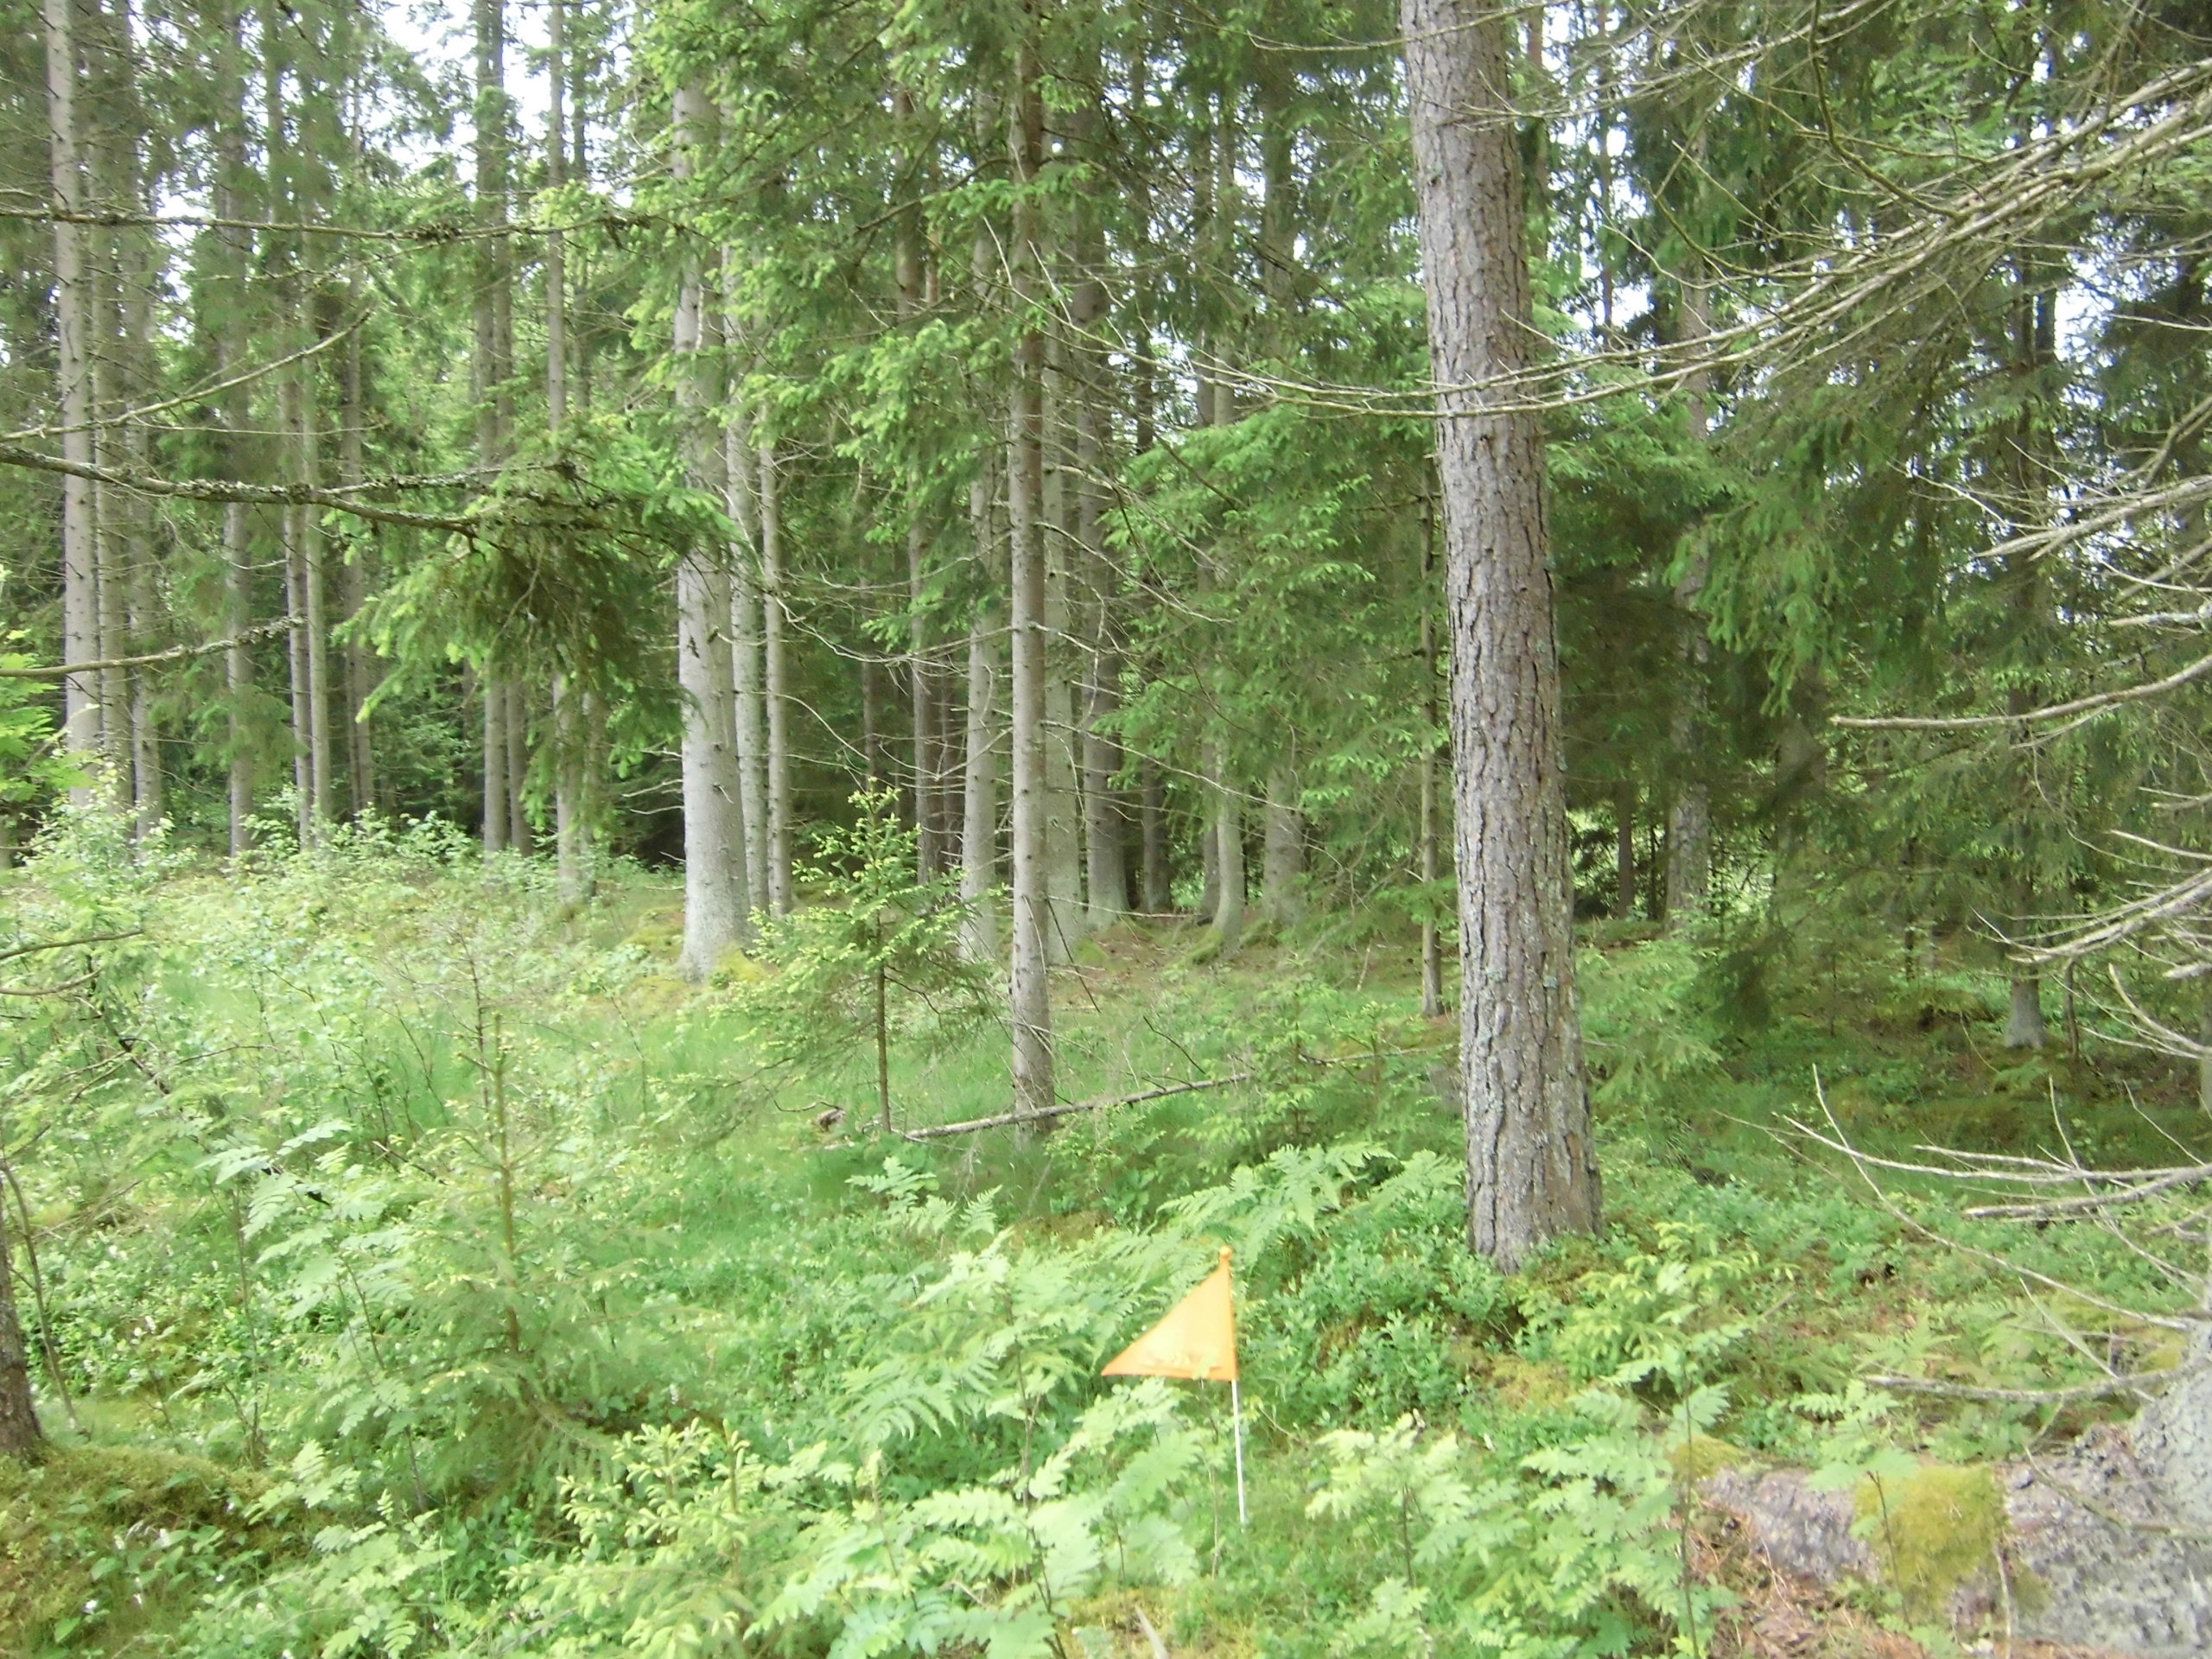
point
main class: Woodland
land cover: Spruce dominated coniferous woodland
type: boreal forest
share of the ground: 50 - 75 %
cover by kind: coniferous forest trees 55 %, shrubs 15 %, broadleaved forest trees 10 %, herbaceous plants 10 %, lichens and mosses 10 %
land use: Forestry
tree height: > 5 m
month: June
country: SE
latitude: 57.0159
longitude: 14.8225
